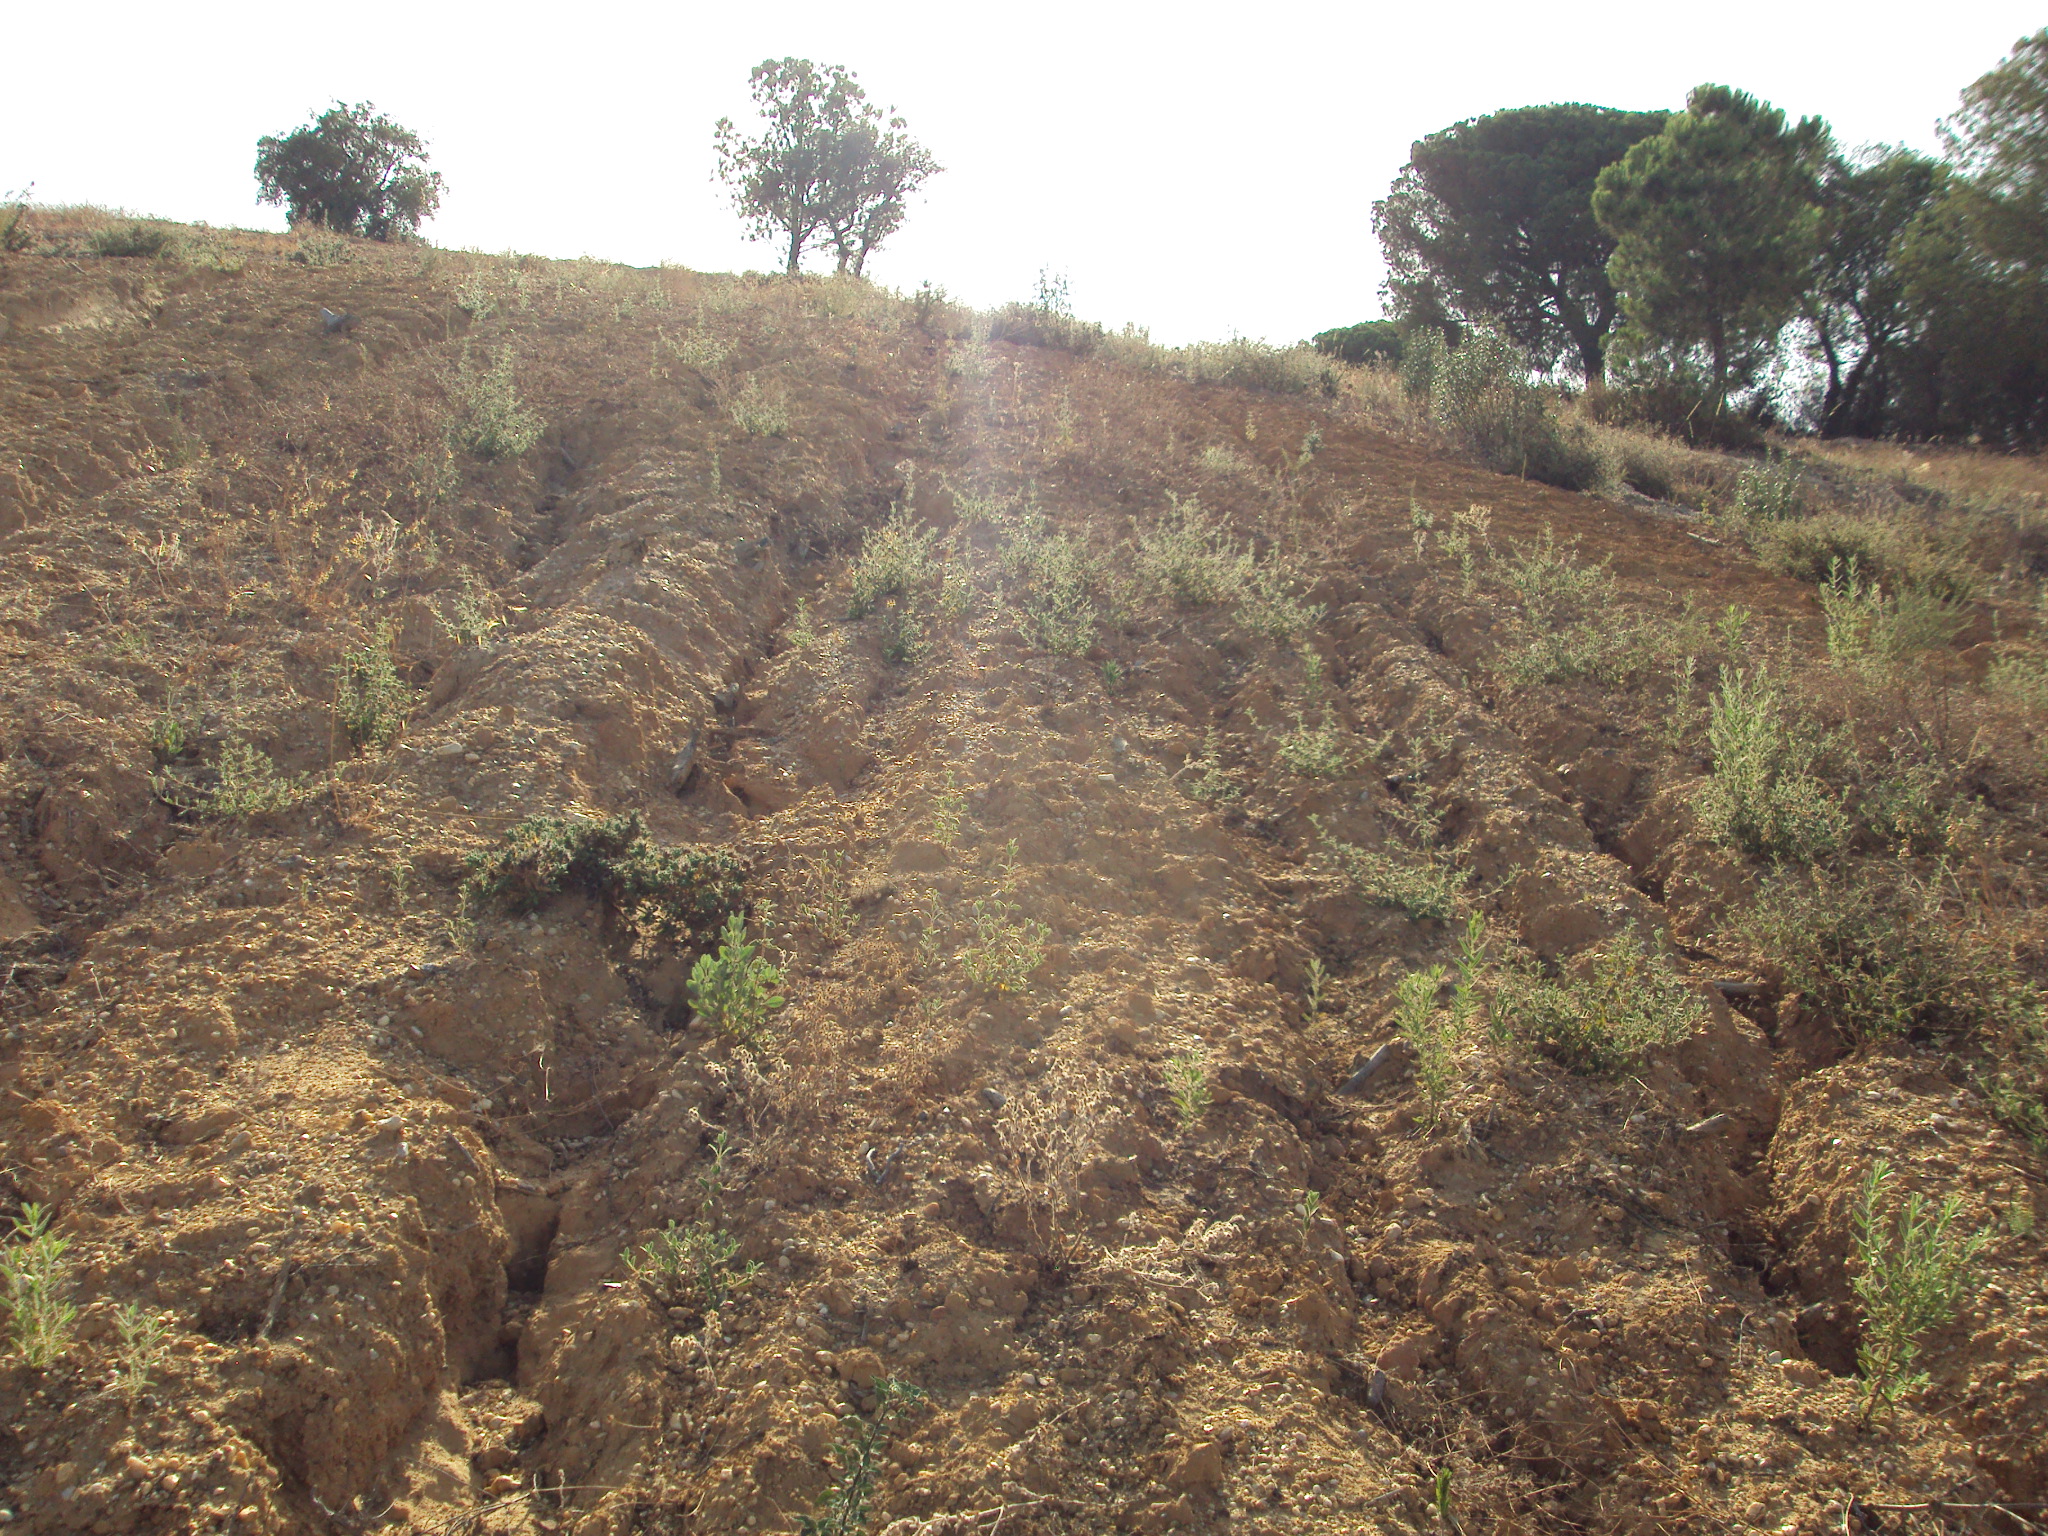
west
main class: Grassland
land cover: Spontaneously vegetated surfaces
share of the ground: > 75 %
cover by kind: herbaceous plants 65 %, unconsolidated bare surface 30 %, shrubs 5 %
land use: Agriculture (excluding fallow land and kitchen gardens)
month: July
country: ES
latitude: 37.3367
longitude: -7.0743
